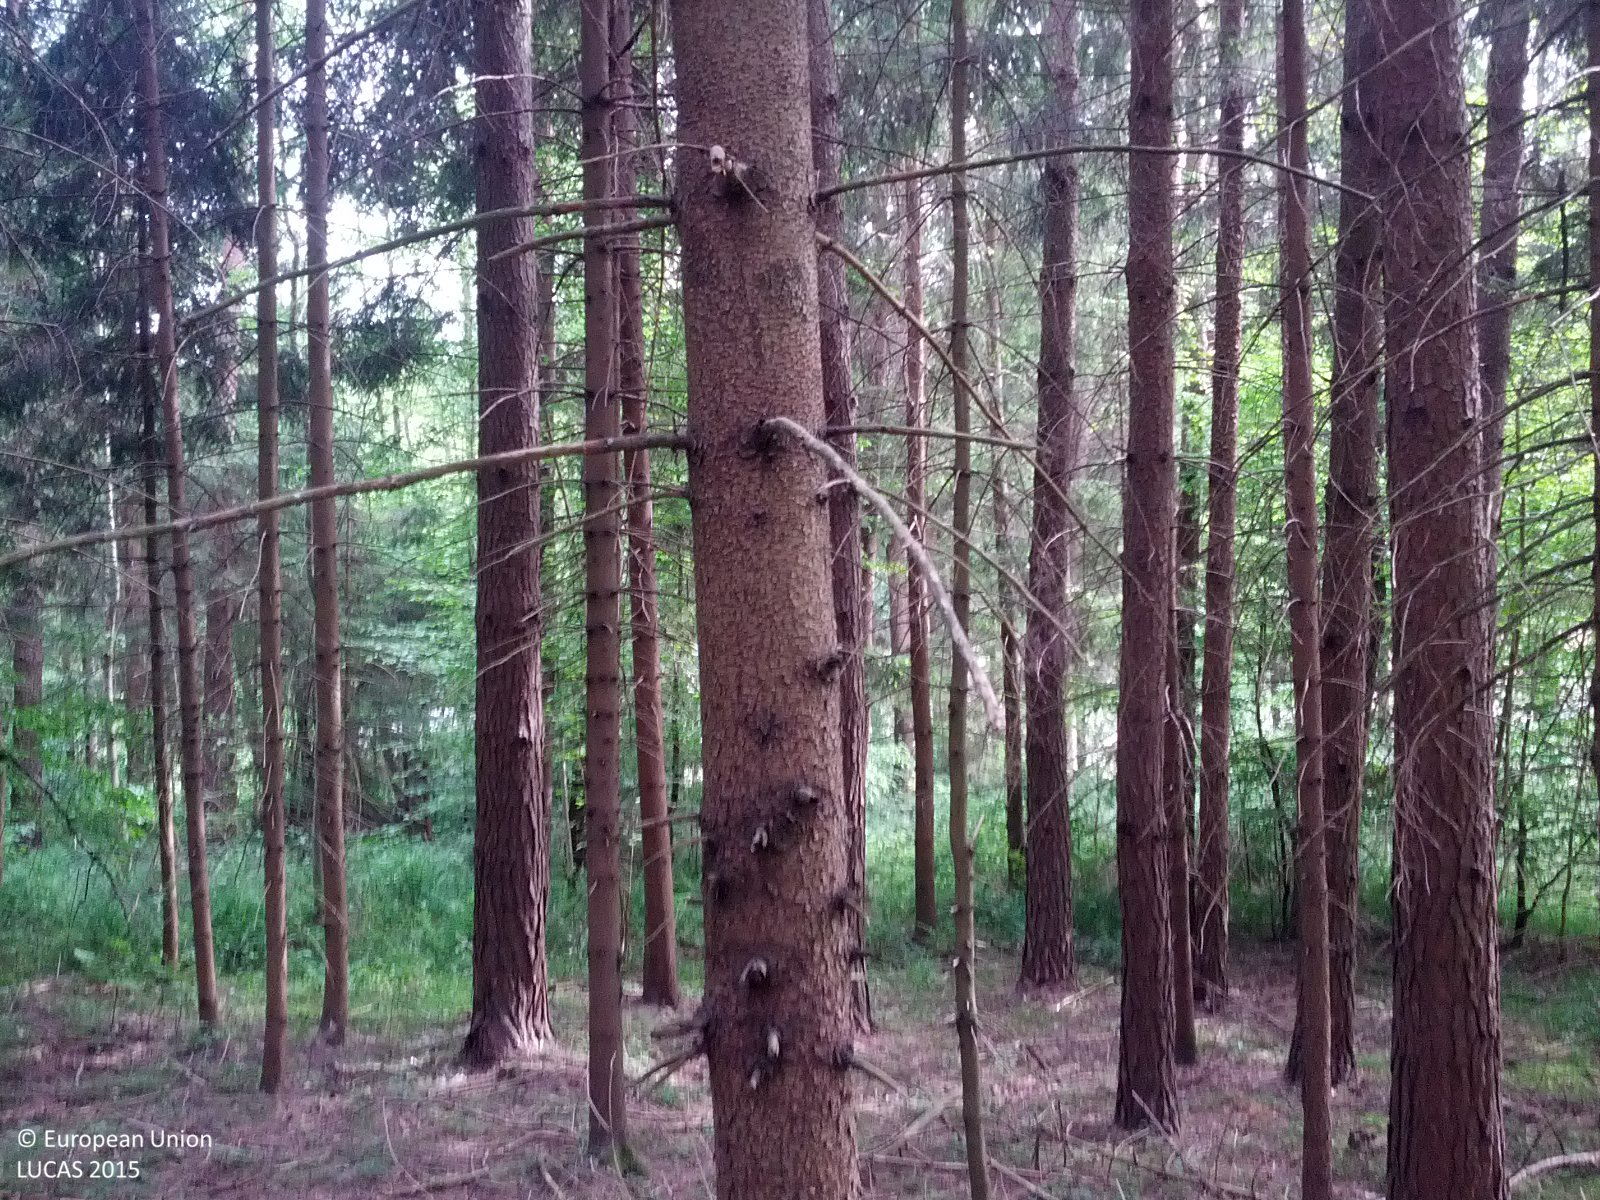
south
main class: Woodland
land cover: Pine dominated coniferous woodland
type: hemiboreal forest and nemoral coniferous forest and mixed broadleaved-coniferous forest
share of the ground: > 75 %
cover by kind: coniferous forest trees 70 %, broadleaved forest trees 10 %, herbaceous plants 10 %, shrubs 5 %, lichens and mosses 5 %
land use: Forestry
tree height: > 5 m
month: May
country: AT
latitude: 47.3505
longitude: 16.1048
